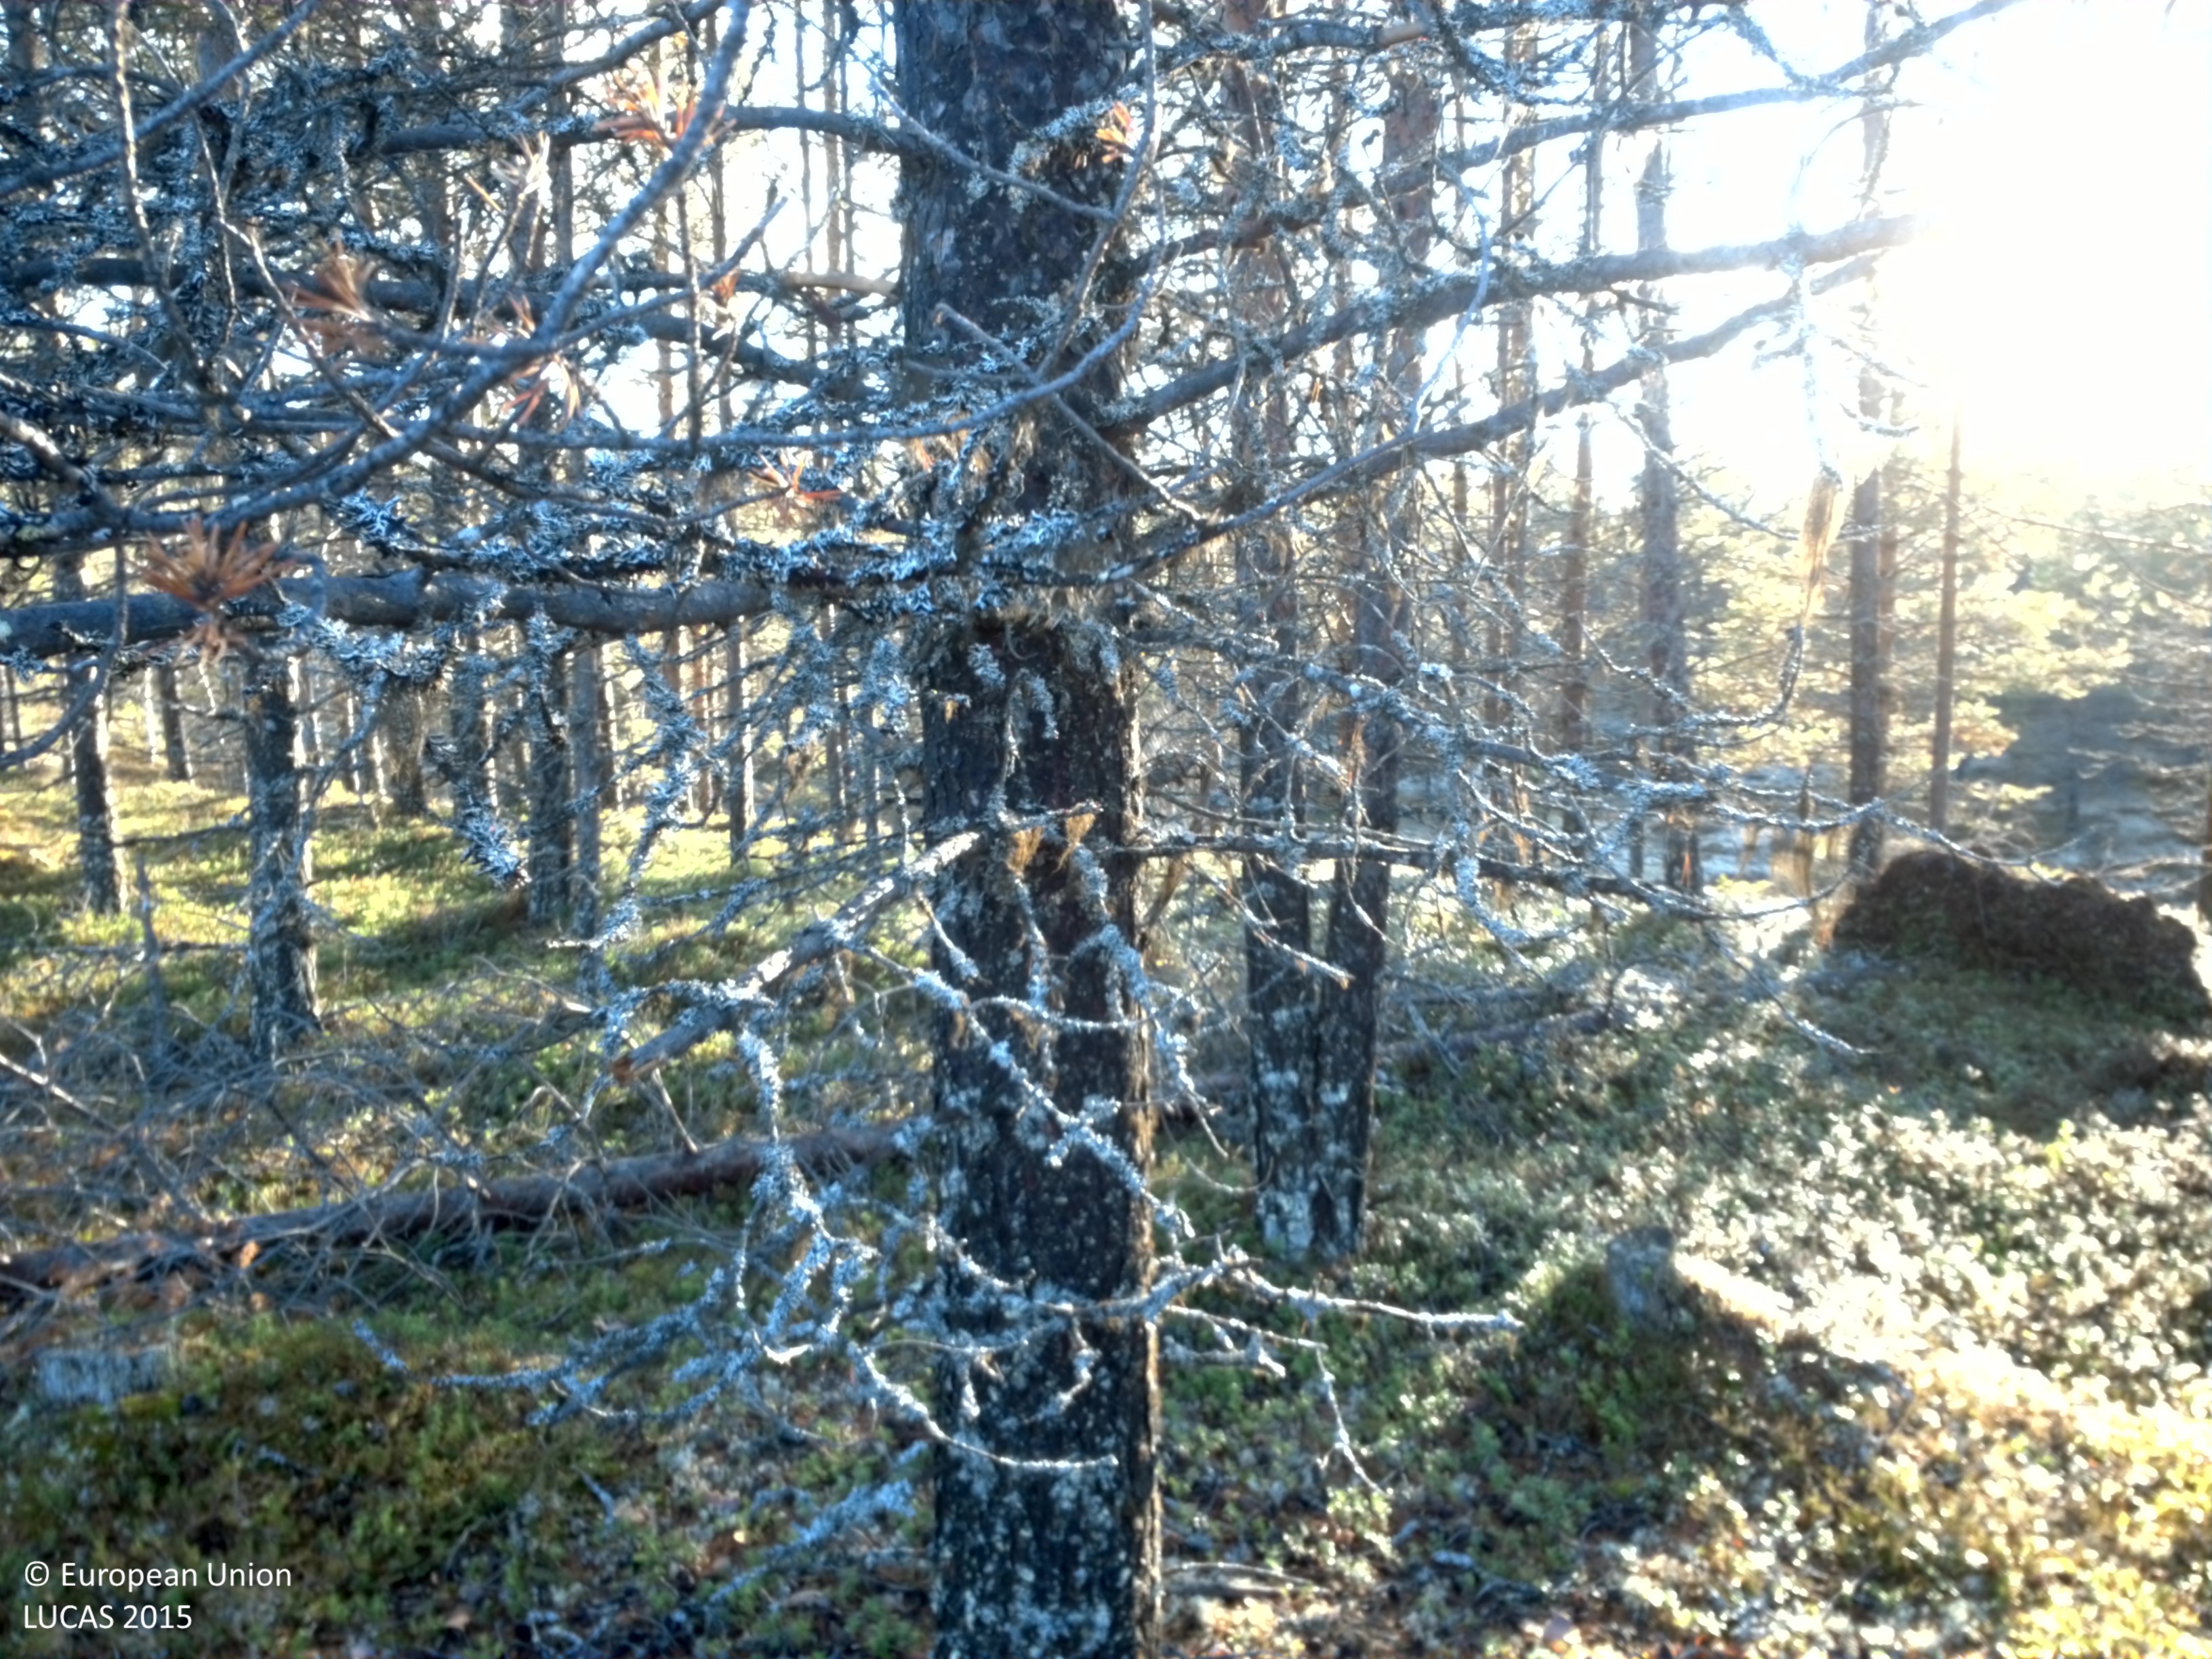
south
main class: Woodland
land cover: Pine dominated mixed woodland
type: boreal forest
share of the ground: 25 - 50 %
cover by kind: shrubs 40 %, lichens and mosses 30 %, coniferous forest trees 20 %, broadleaved forest trees 10 %
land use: Forestry
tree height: > 5 m
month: October
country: SE
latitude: 64.4958
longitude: 17.4399
